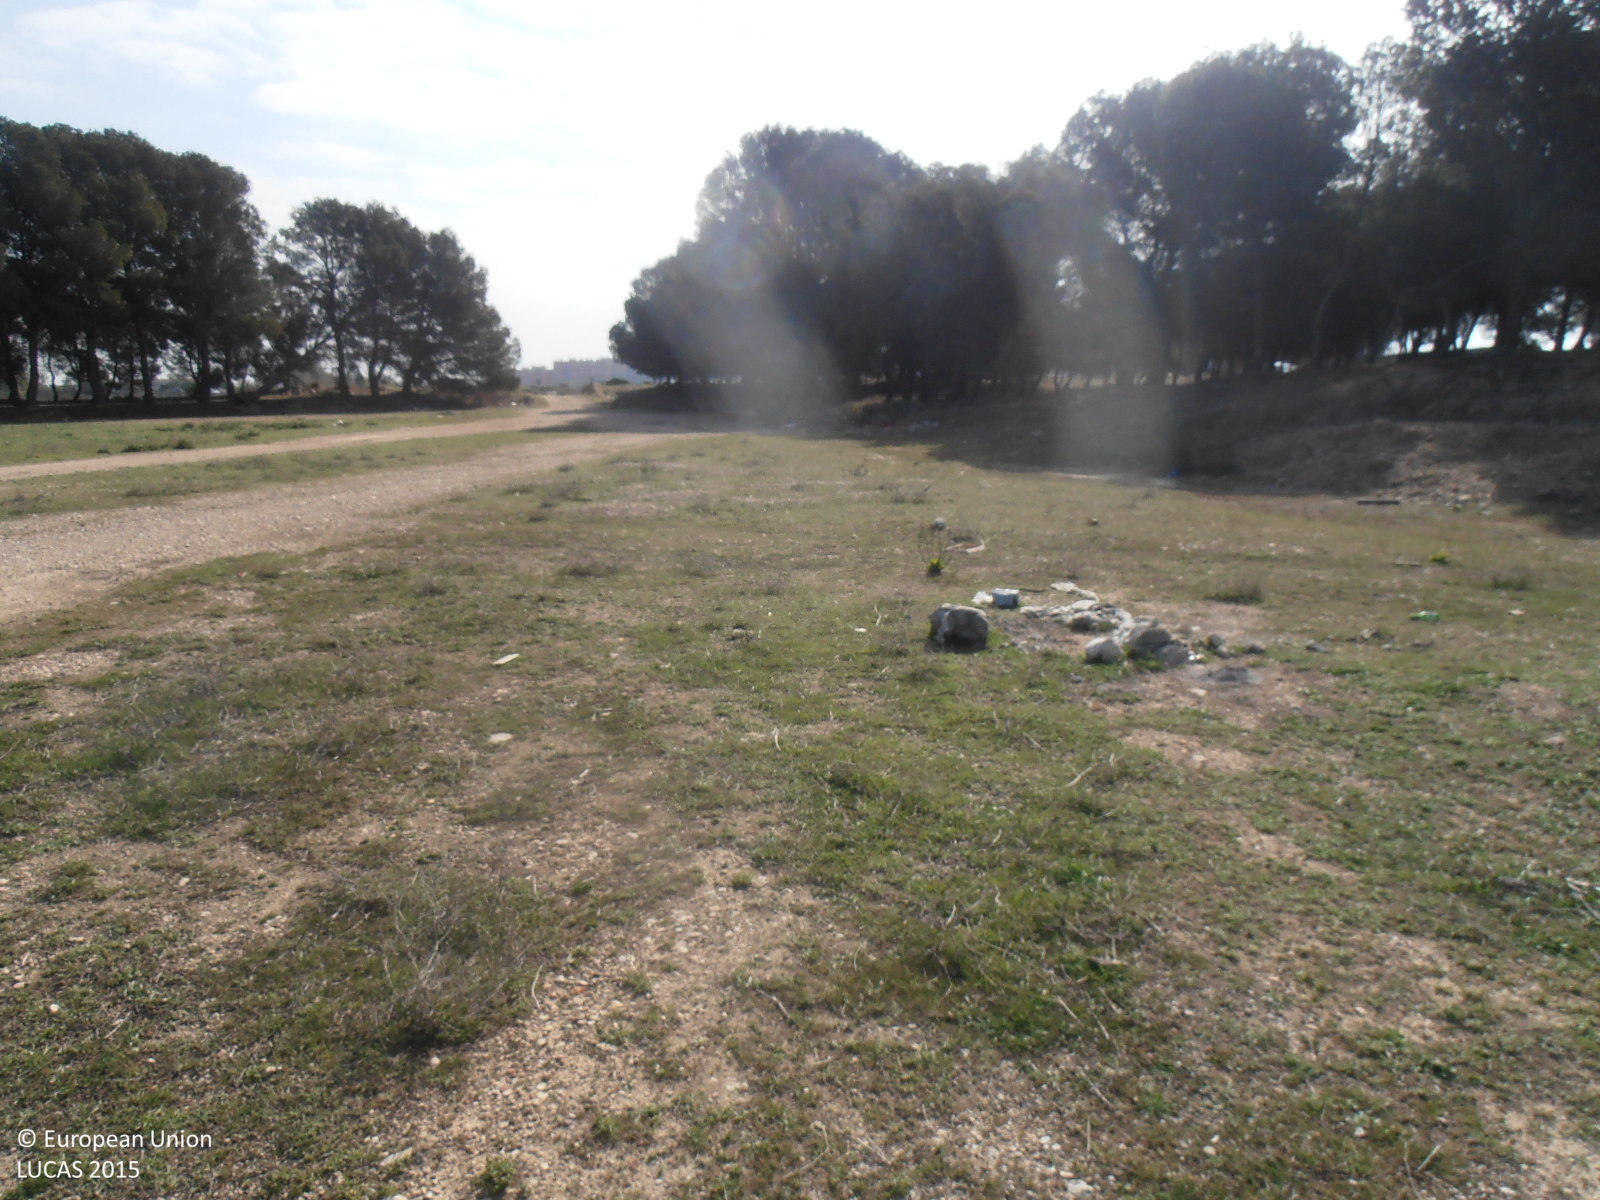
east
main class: Grassland
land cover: Grassland without tree/shrub cover
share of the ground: > 75 %
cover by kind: herbaceous plants 95 %, shrubs 5 %
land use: Abandoned areas
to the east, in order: Grassland without tree/shrub cover; Pine dominated coniferous woodland; Shrubland without tree cover; Paved roads, cycling and walking lanes; Artificial constructions in urban areas; Paved roads, cycling and walking lanes; Shruby margins; Fences; Artificial constructions in urban areas
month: April
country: ES
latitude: 41.6386
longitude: -0.9589
